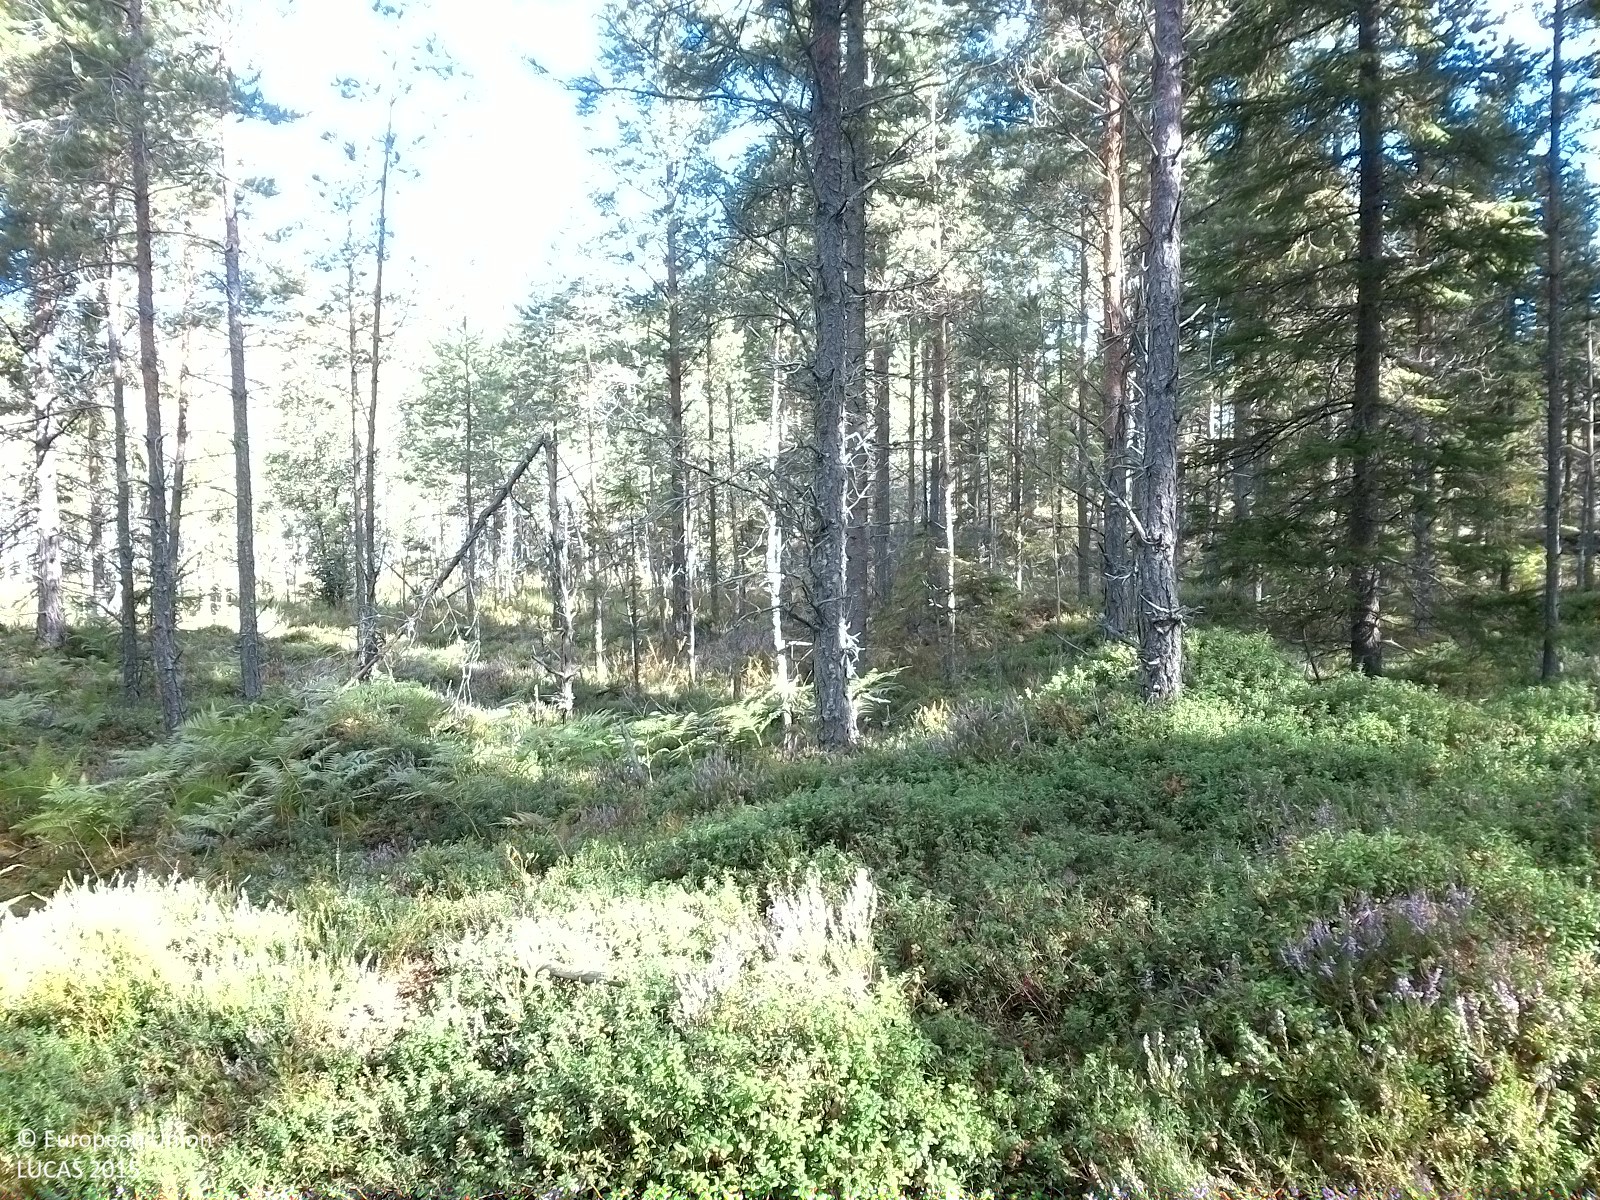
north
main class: Woodland
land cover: Pine dominated coniferous woodland
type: boreal forest
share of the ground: 25 - 50 %
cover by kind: herbaceous plants 45 %, coniferous forest trees 30 %, shrubs 15 %, lichens and mosses 10 %
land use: Forestry
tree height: > 5 m
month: August
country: SE
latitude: 58.9352
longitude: 15.5355
